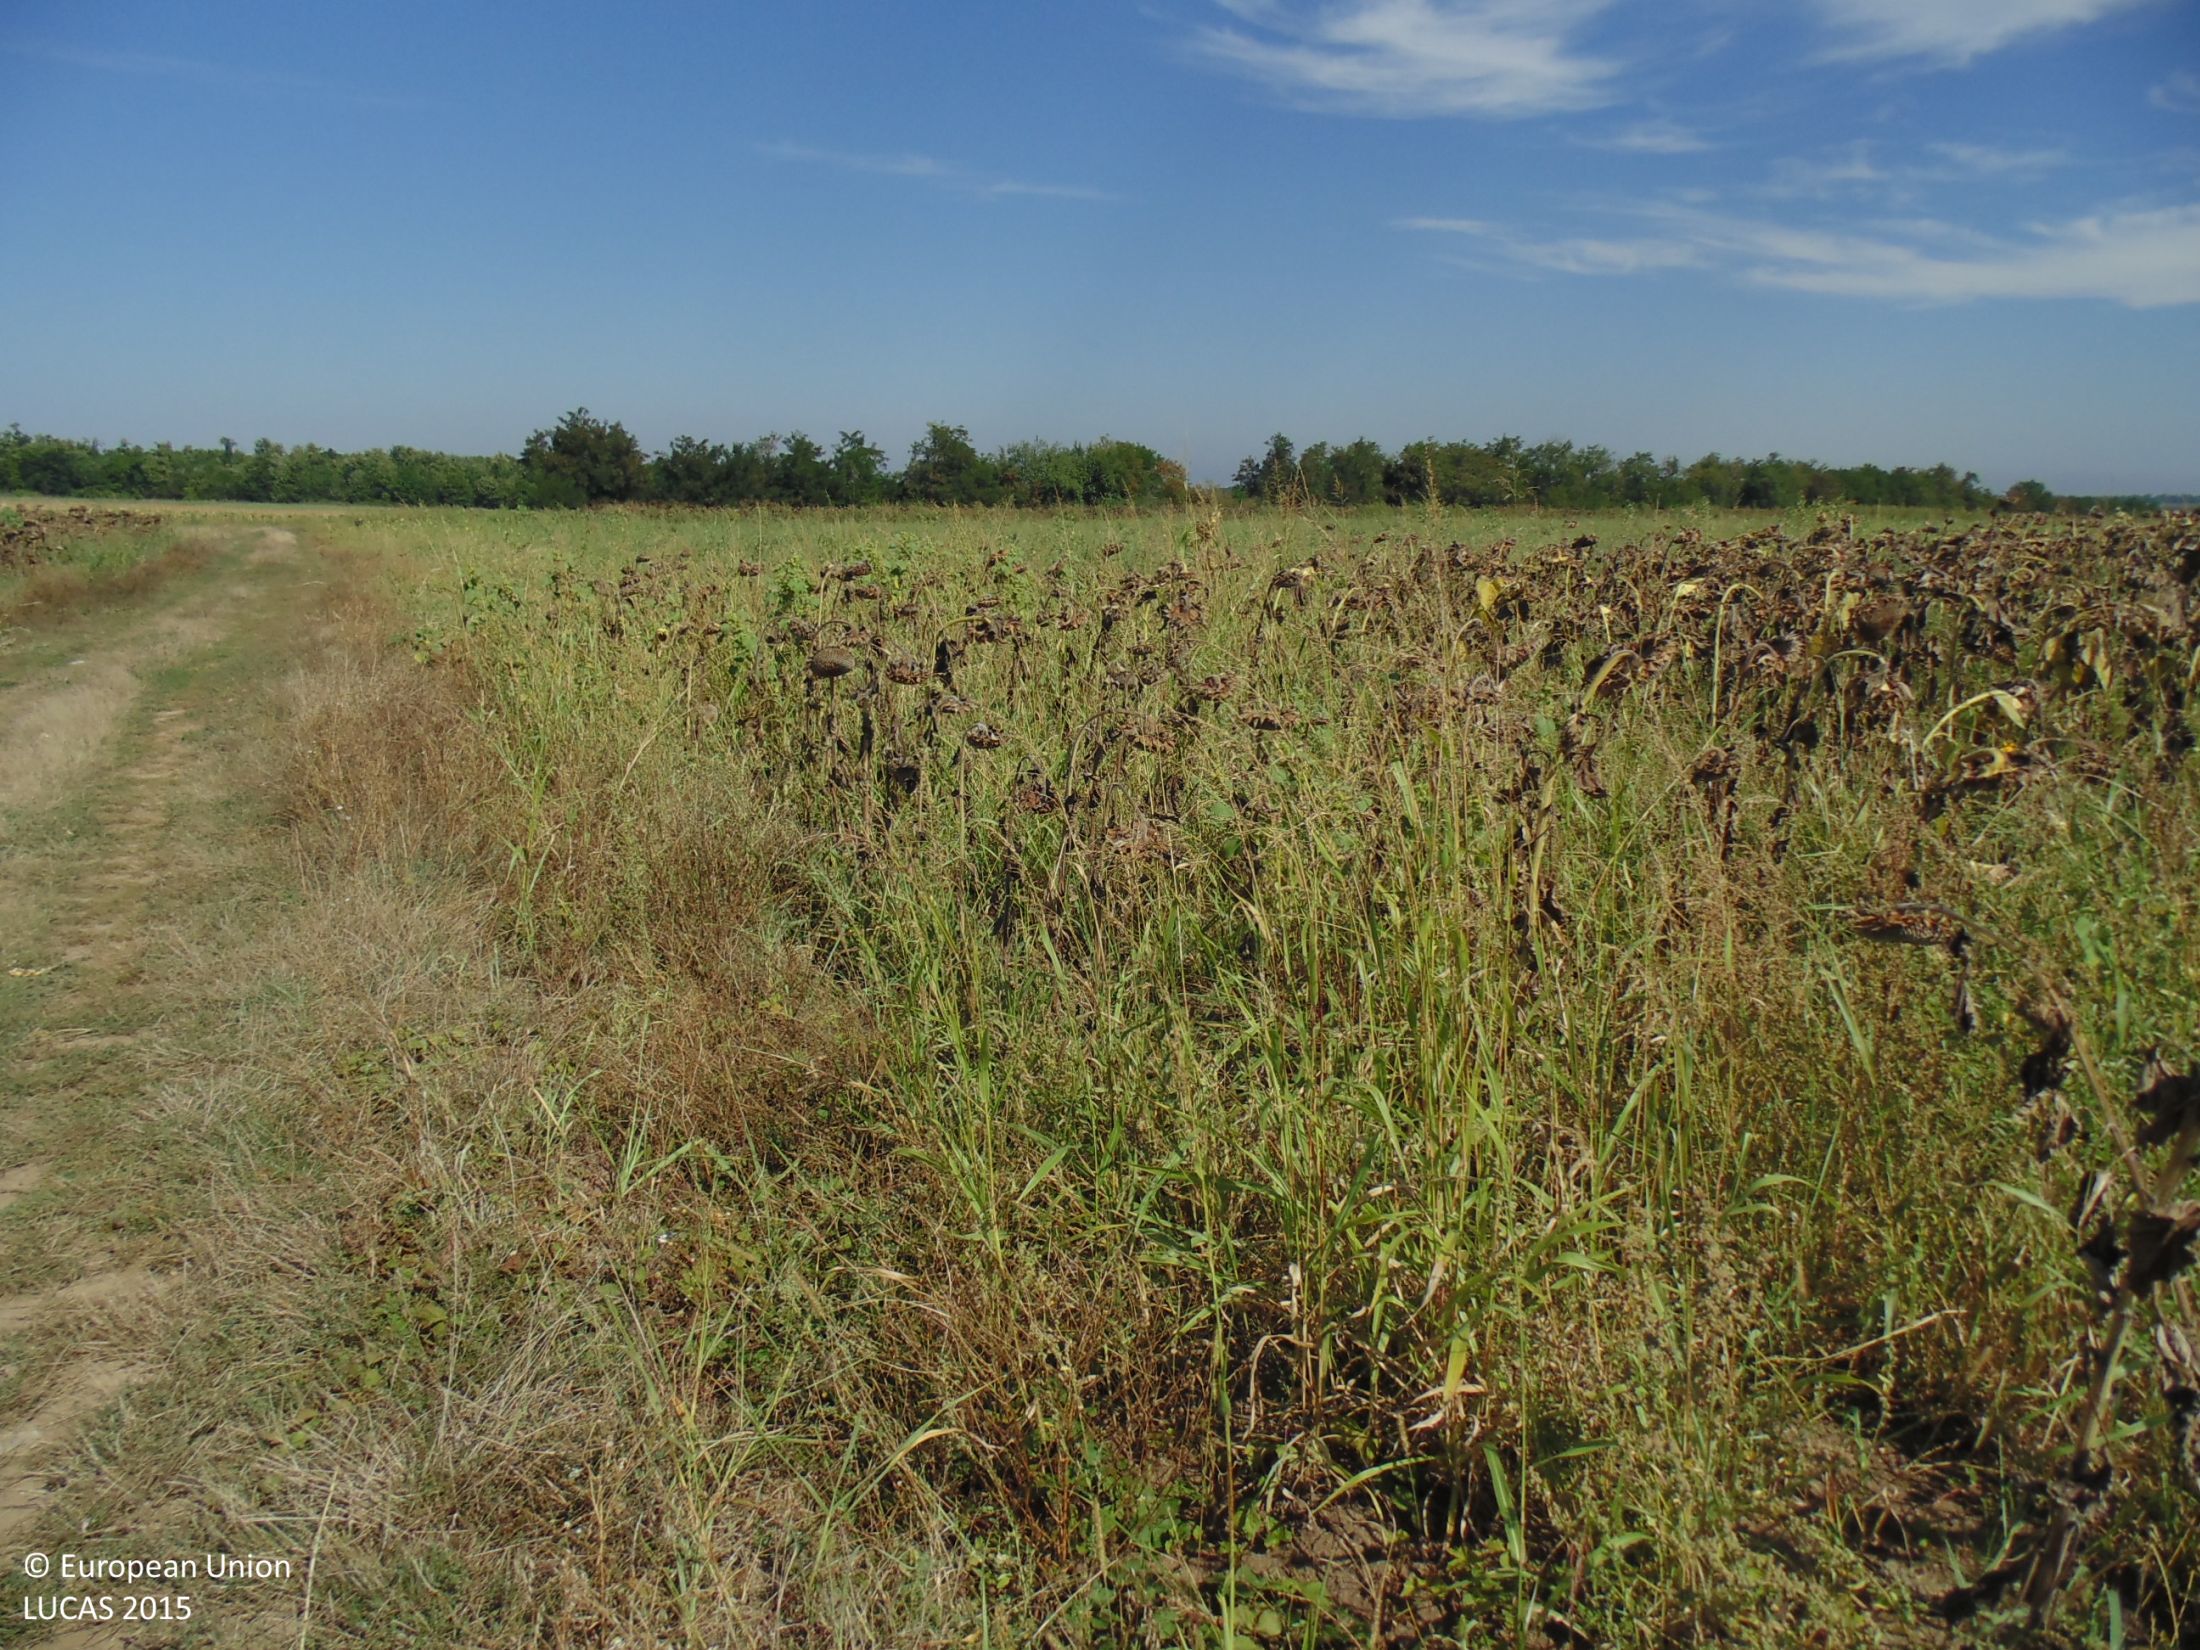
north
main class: Cropland
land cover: Sunflower
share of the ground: > 75 %
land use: Agriculture (excluding fallow land and kitchen gardens)
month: September
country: BG
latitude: 43.8909
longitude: 27.1168
